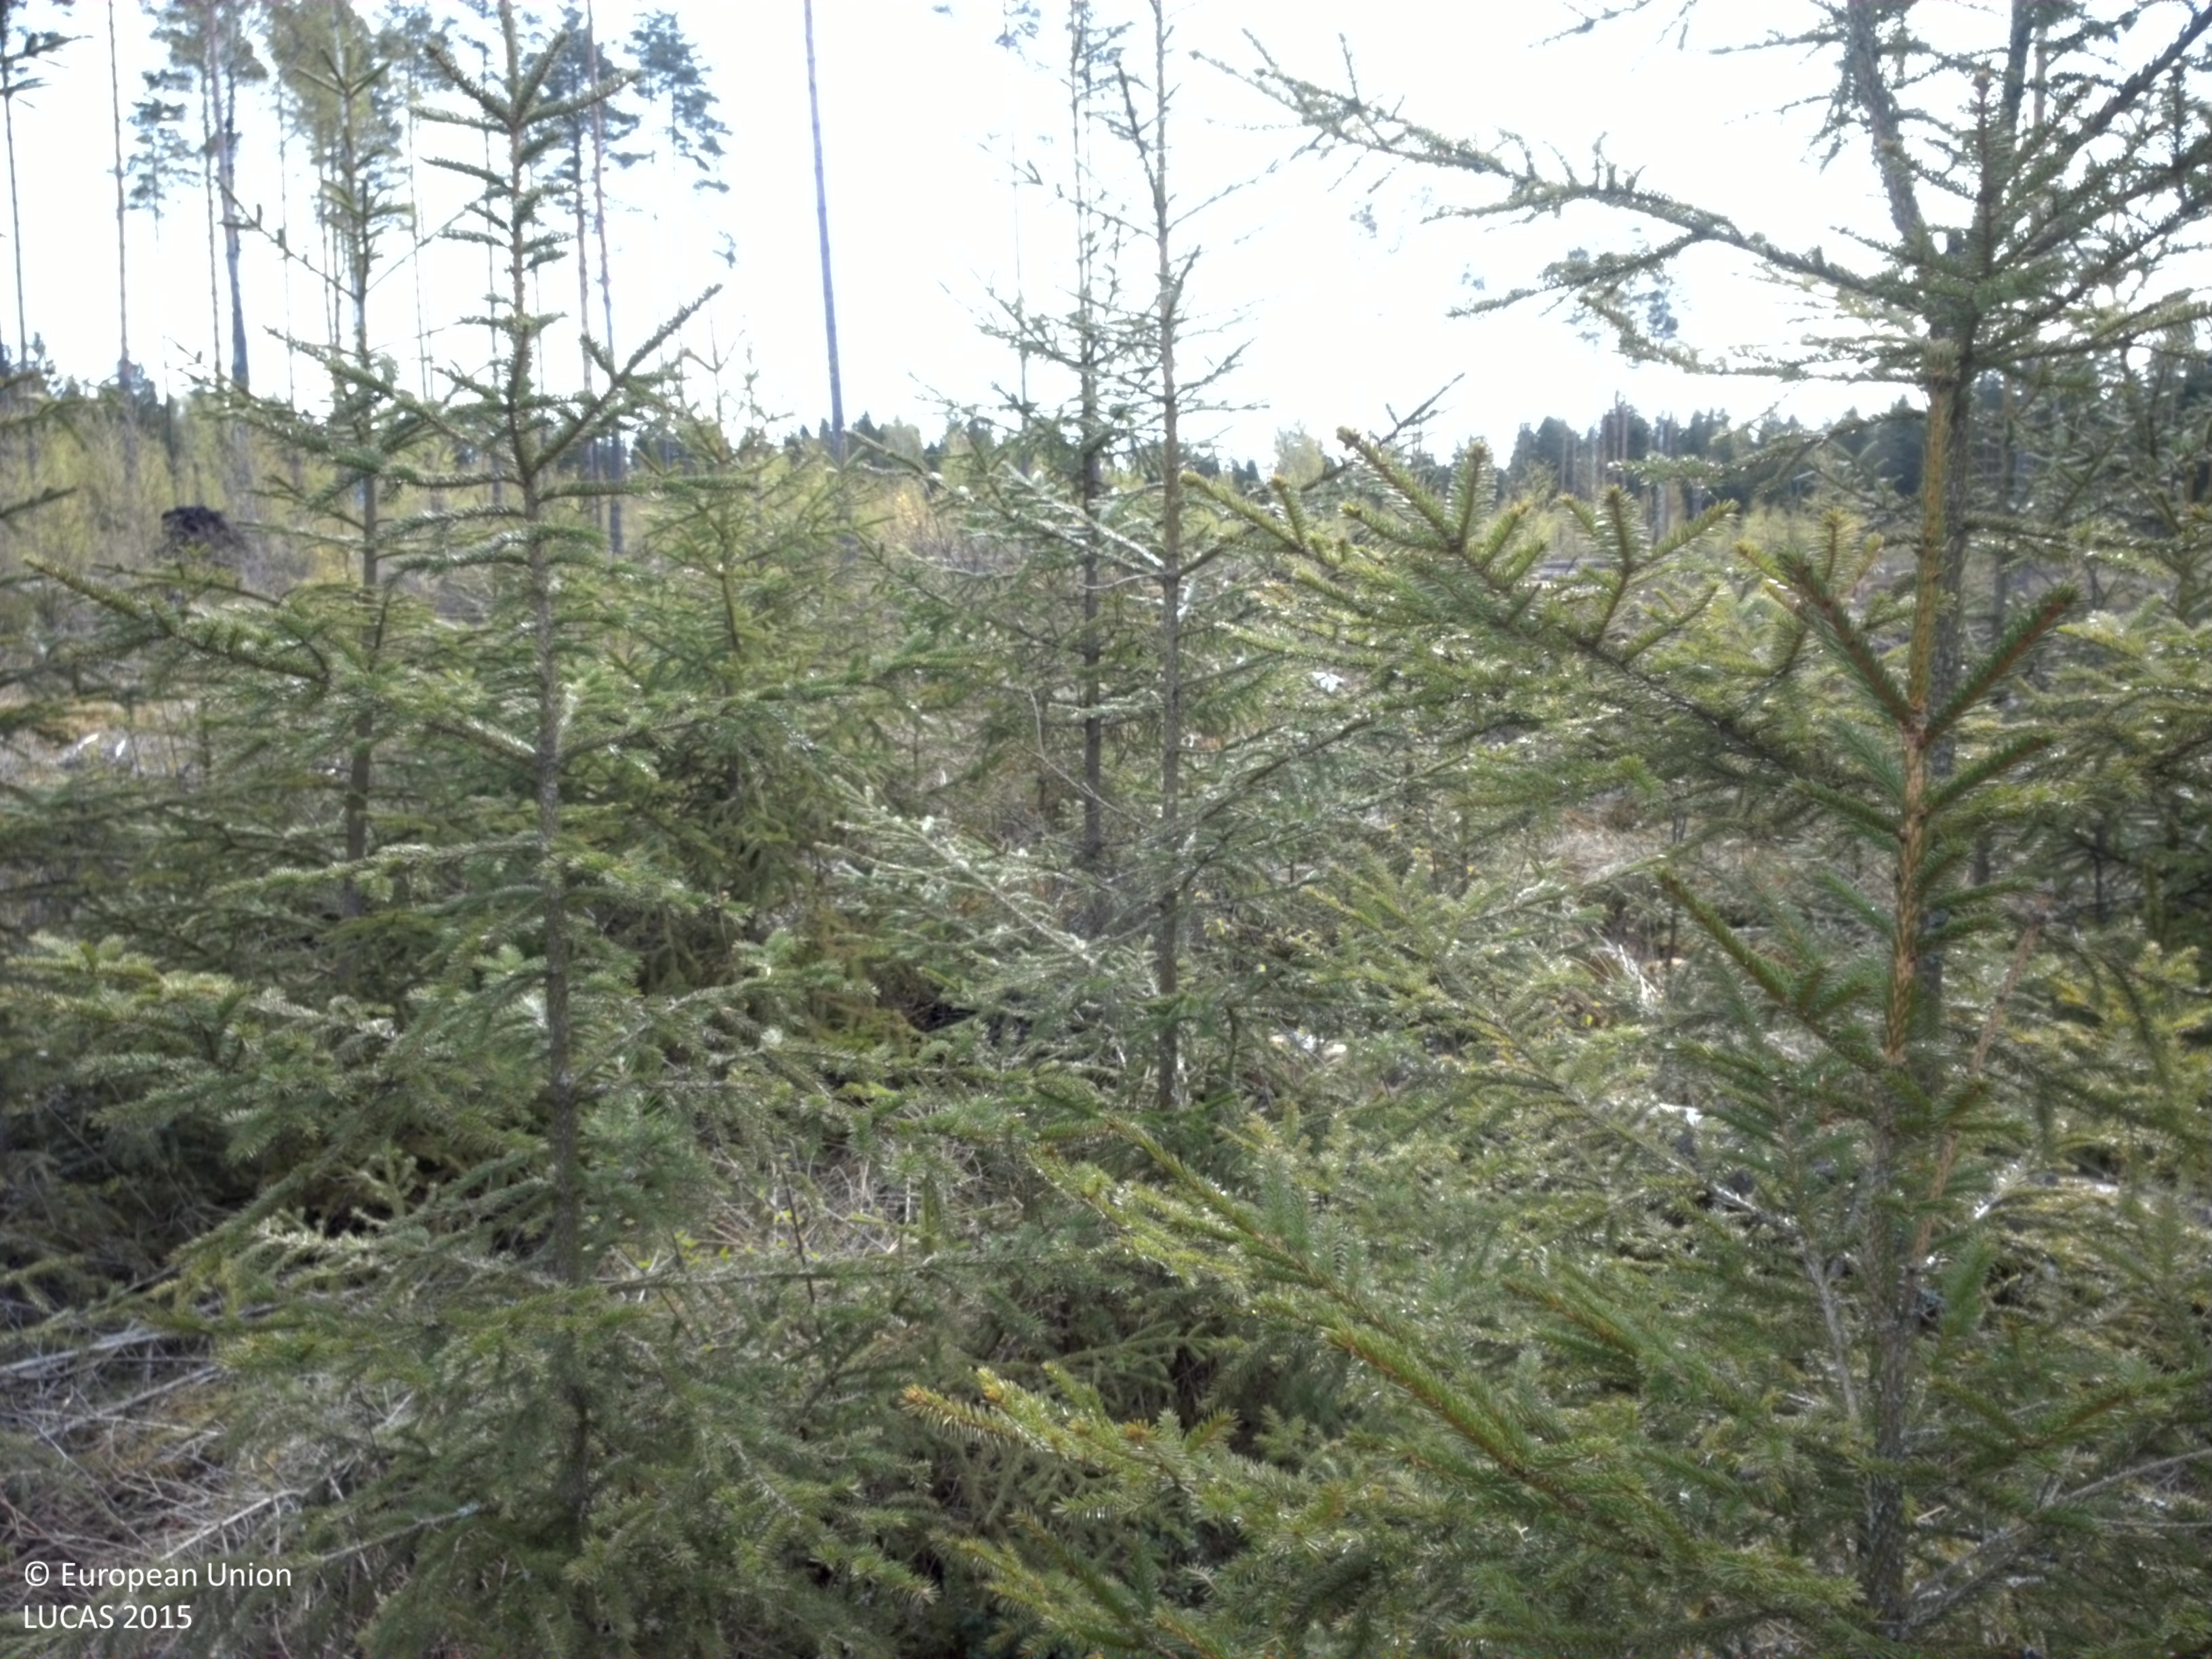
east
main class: Woodland
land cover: Spruce dominated coniferous woodland
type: boreal forest
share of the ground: > 75 %
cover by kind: coniferous forest trees 65 %, herbaceous plants 15 %, broadleaved forest trees 10 %, shrubs 10 %
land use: Forestry
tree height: < 5 m
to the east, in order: Spruce dominated coniferous woodland; Shrubland with sparse tree cover; Broadleaved woodland; Other bare soil; Broadleaved woodland; Electric lines; Broadleaved woodland; Tracks; Broadleaved woodland; Tracks; Spruce dominated coniferous woodland
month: May
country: SE
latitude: 56.8019
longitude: 14.7626
